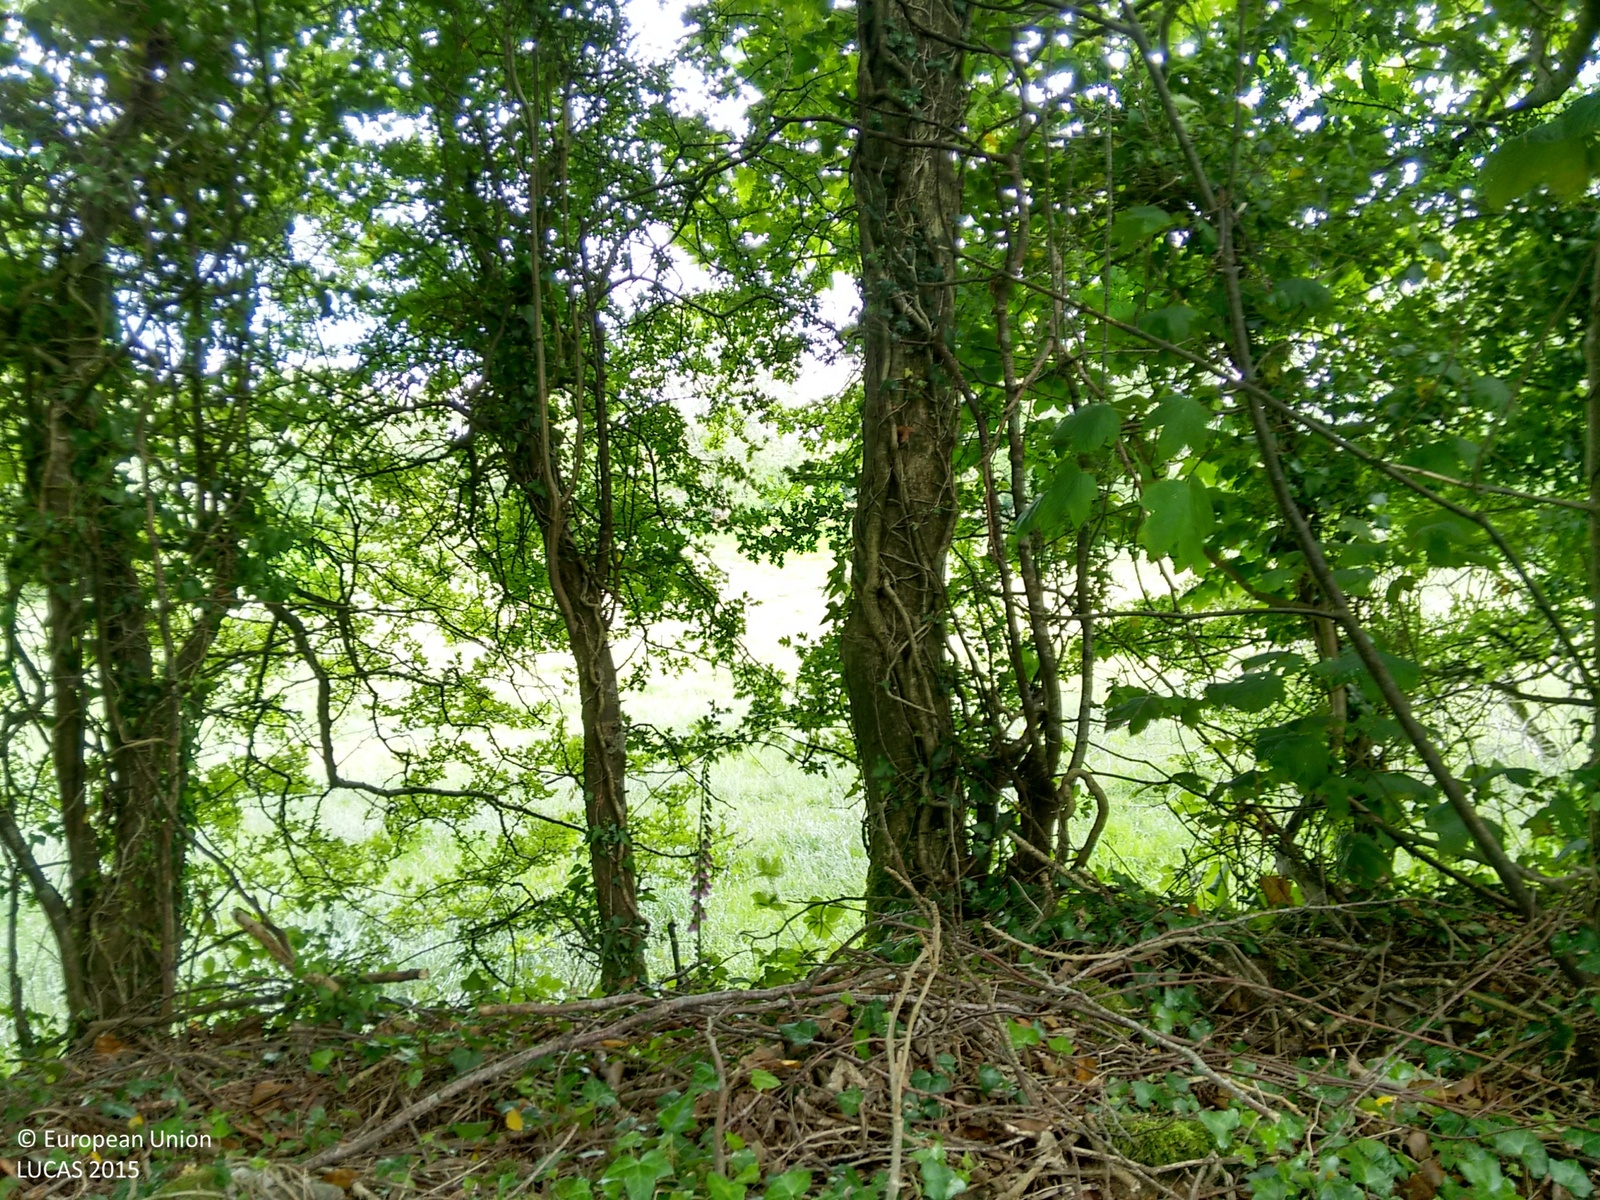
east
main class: Grassland
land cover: Grassland without tree/shrub cover
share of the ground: > 75 %
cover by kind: herbaceous plants 100 %
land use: Agriculture (excluding fallow land and kitchen gardens)
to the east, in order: Grassland without tree/shrub cover; Shrubland without tree cover; Grassland without tree/shrub cover; Dry stone walls; Abandoned hedges; Grassland without tree/shrub cover; Broadleaved woodland; Grassland without tree/shrub cover
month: June
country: IE
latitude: 52.2173
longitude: -7.2922
